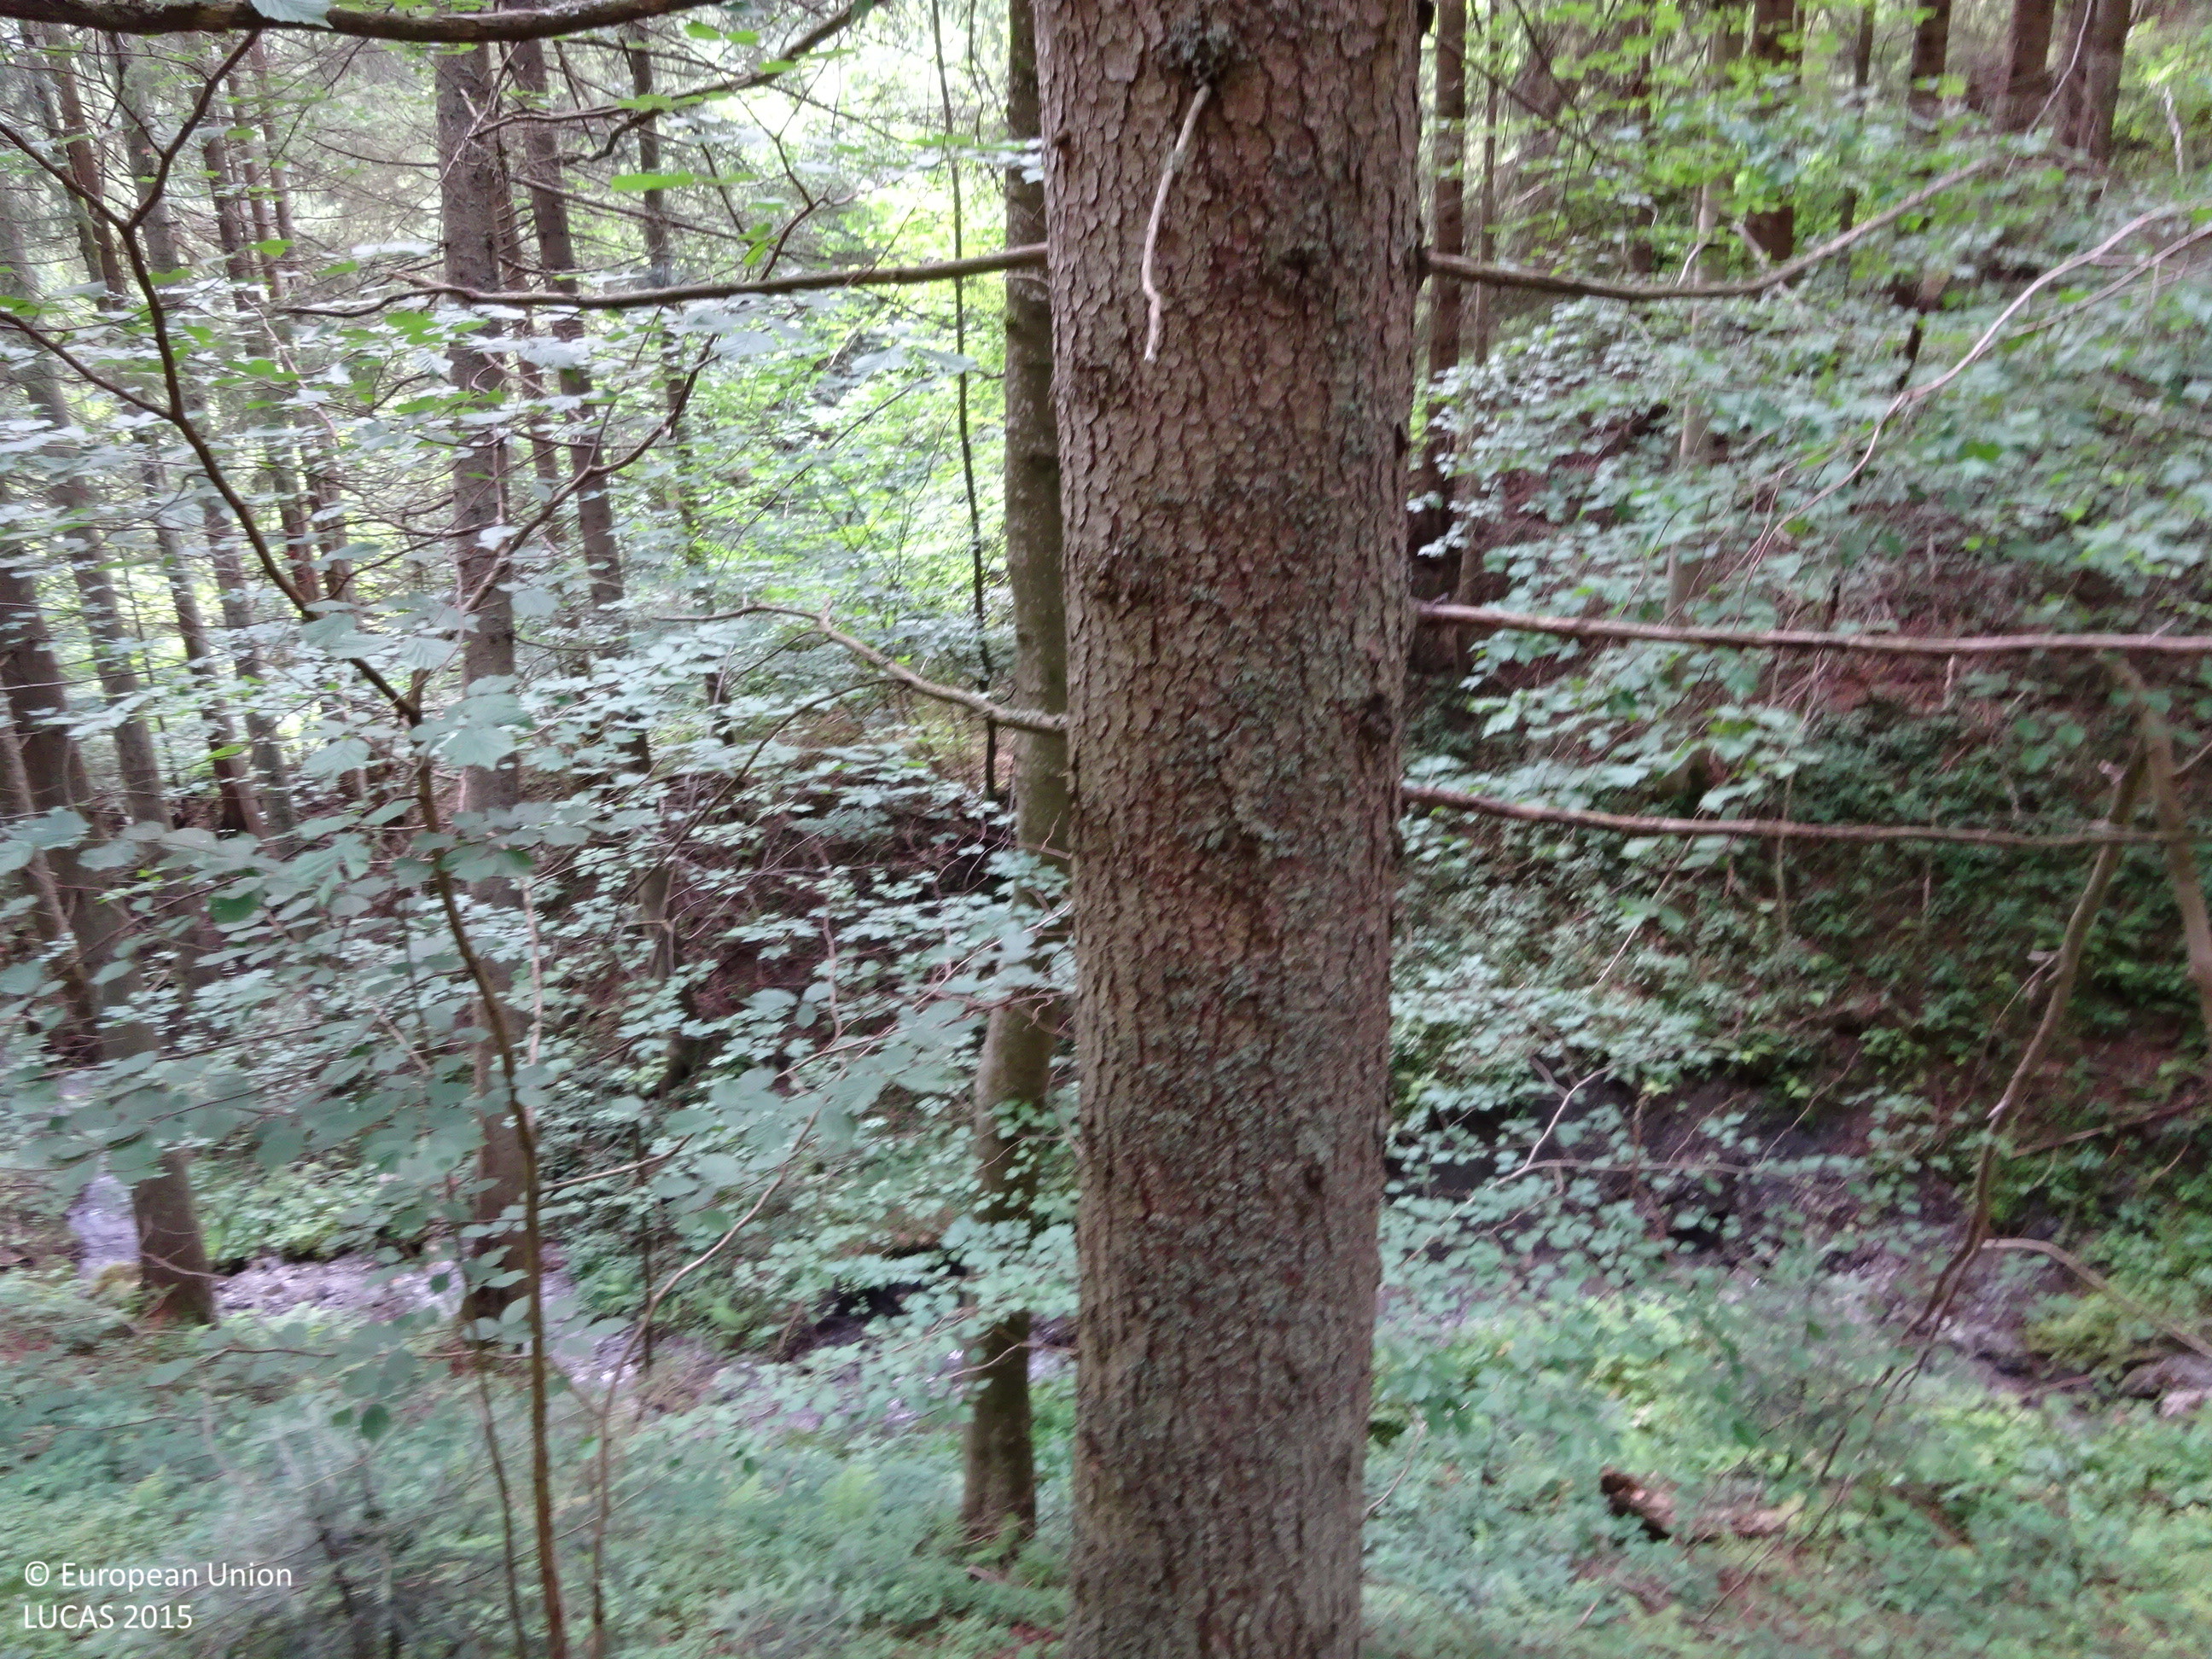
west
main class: Woodland
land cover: Spruce dominated coniferous woodland
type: alpine coniferous forest
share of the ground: > 75 %
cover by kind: coniferous forest trees 100 %
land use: Forestry
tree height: > 5 m
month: July
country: AT
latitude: 47.3995
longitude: 15.5260
